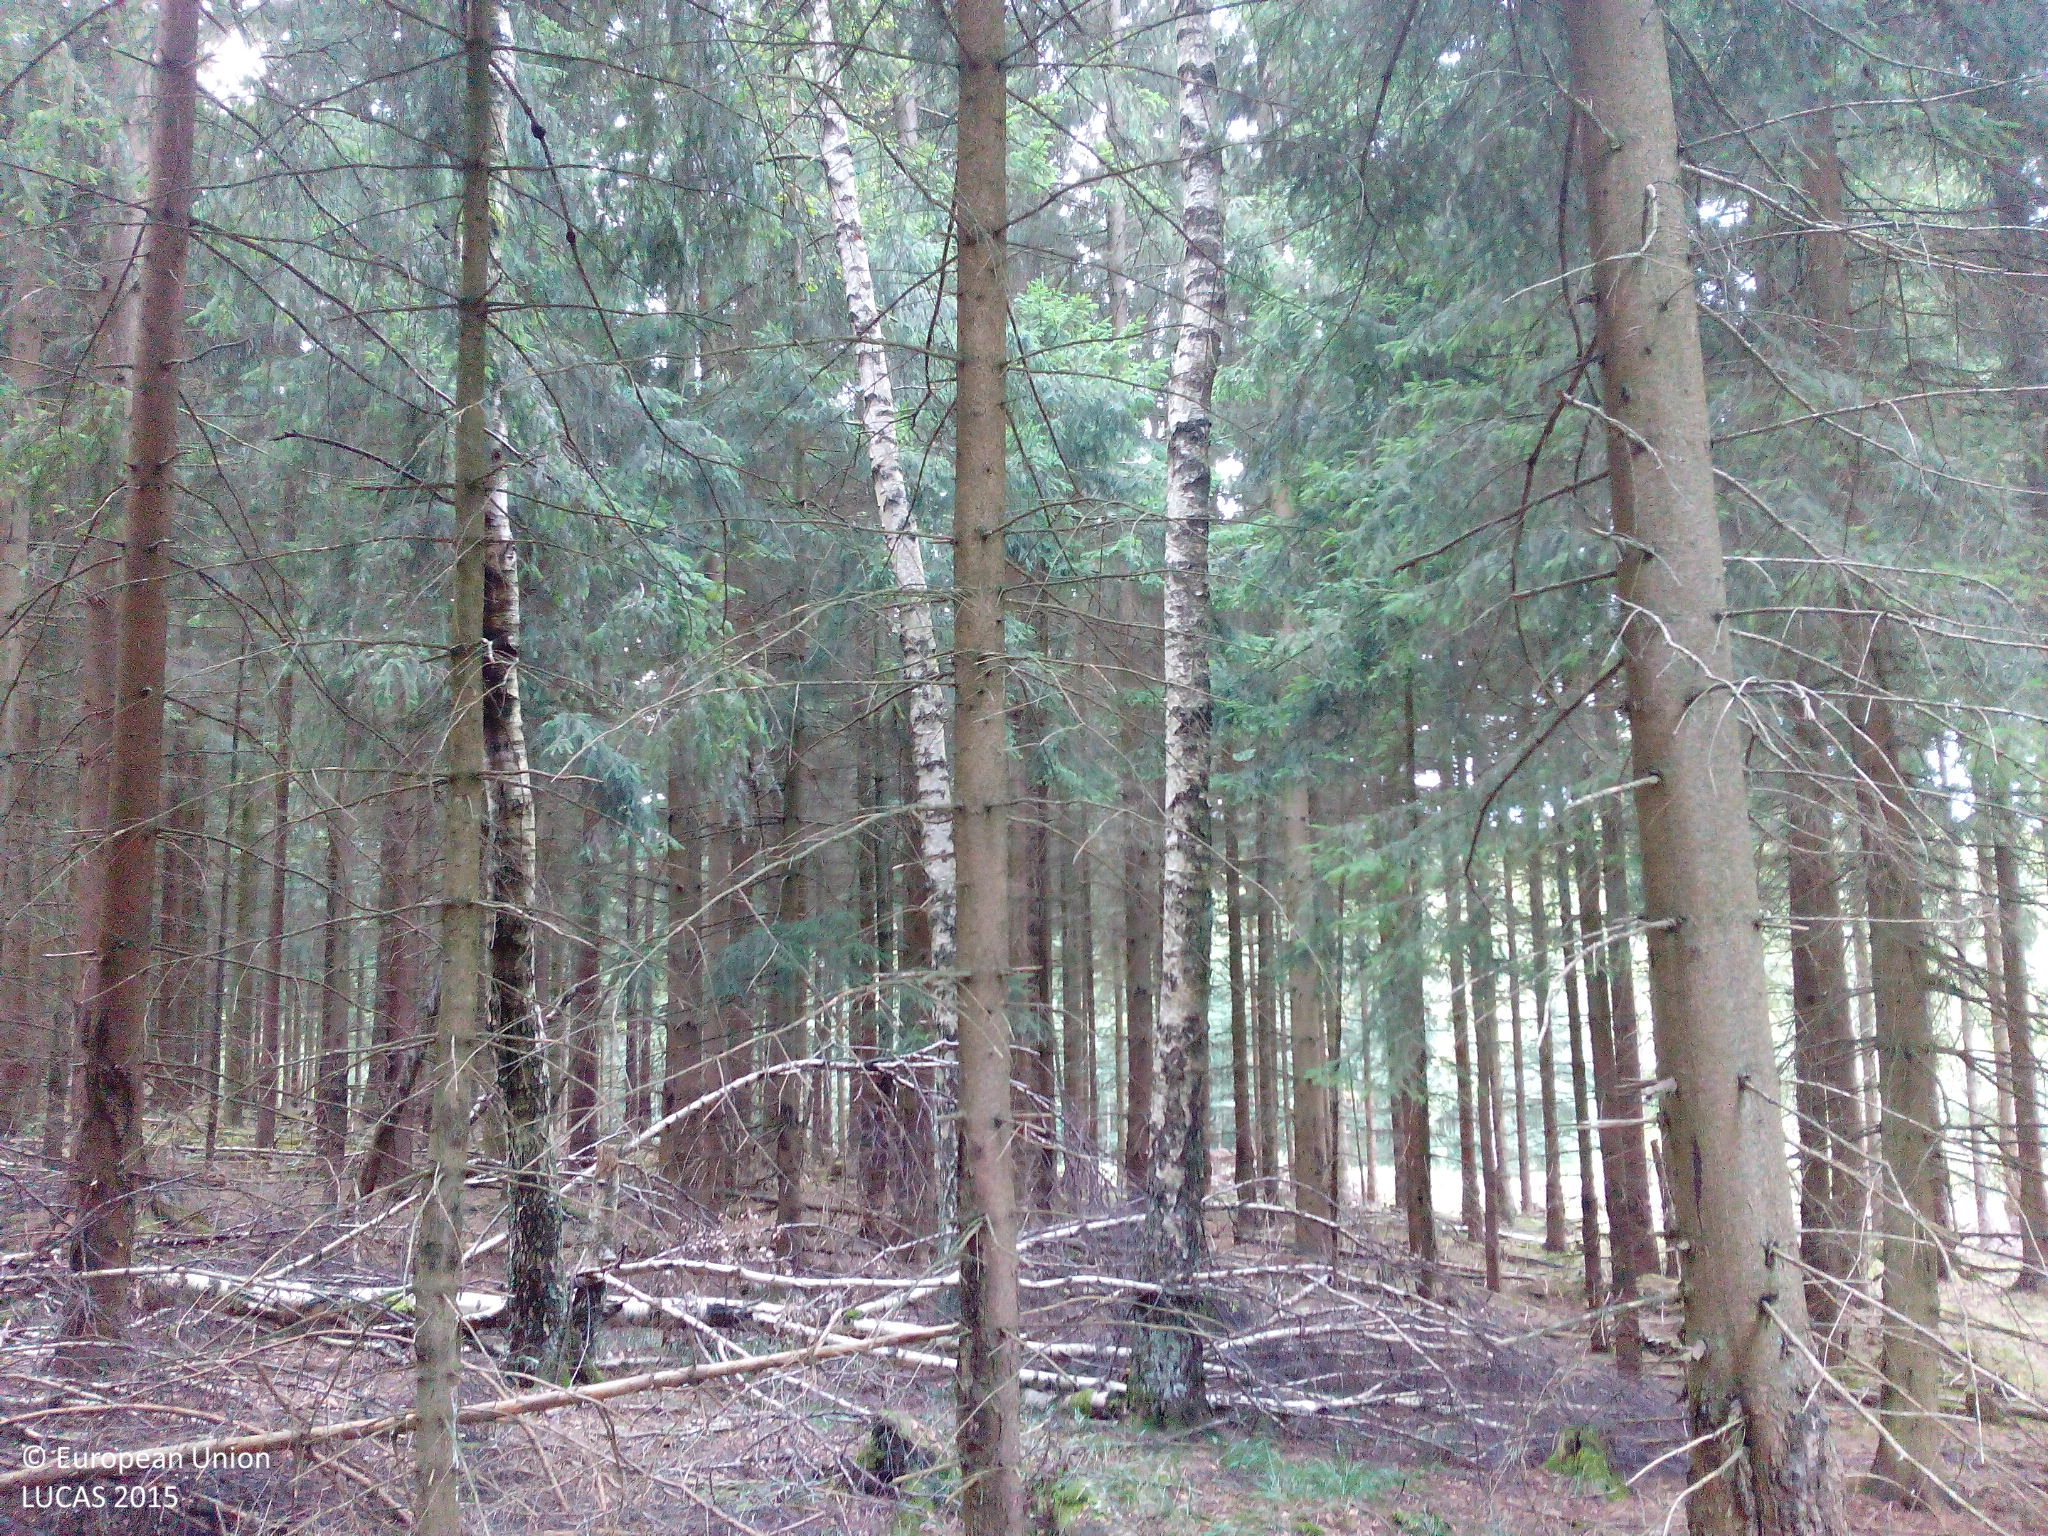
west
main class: Woodland
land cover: Spruce dominated coniferous woodland
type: hemiboreal forest and nemoral coniferous forest and mixed broadleaved-coniferous forest
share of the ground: > 75 %
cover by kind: coniferous forest trees 90 %, broadleaved forest trees 10 %
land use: Forestry
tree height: > 5 m
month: September
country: DE
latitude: 51.5821
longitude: 11.0243
